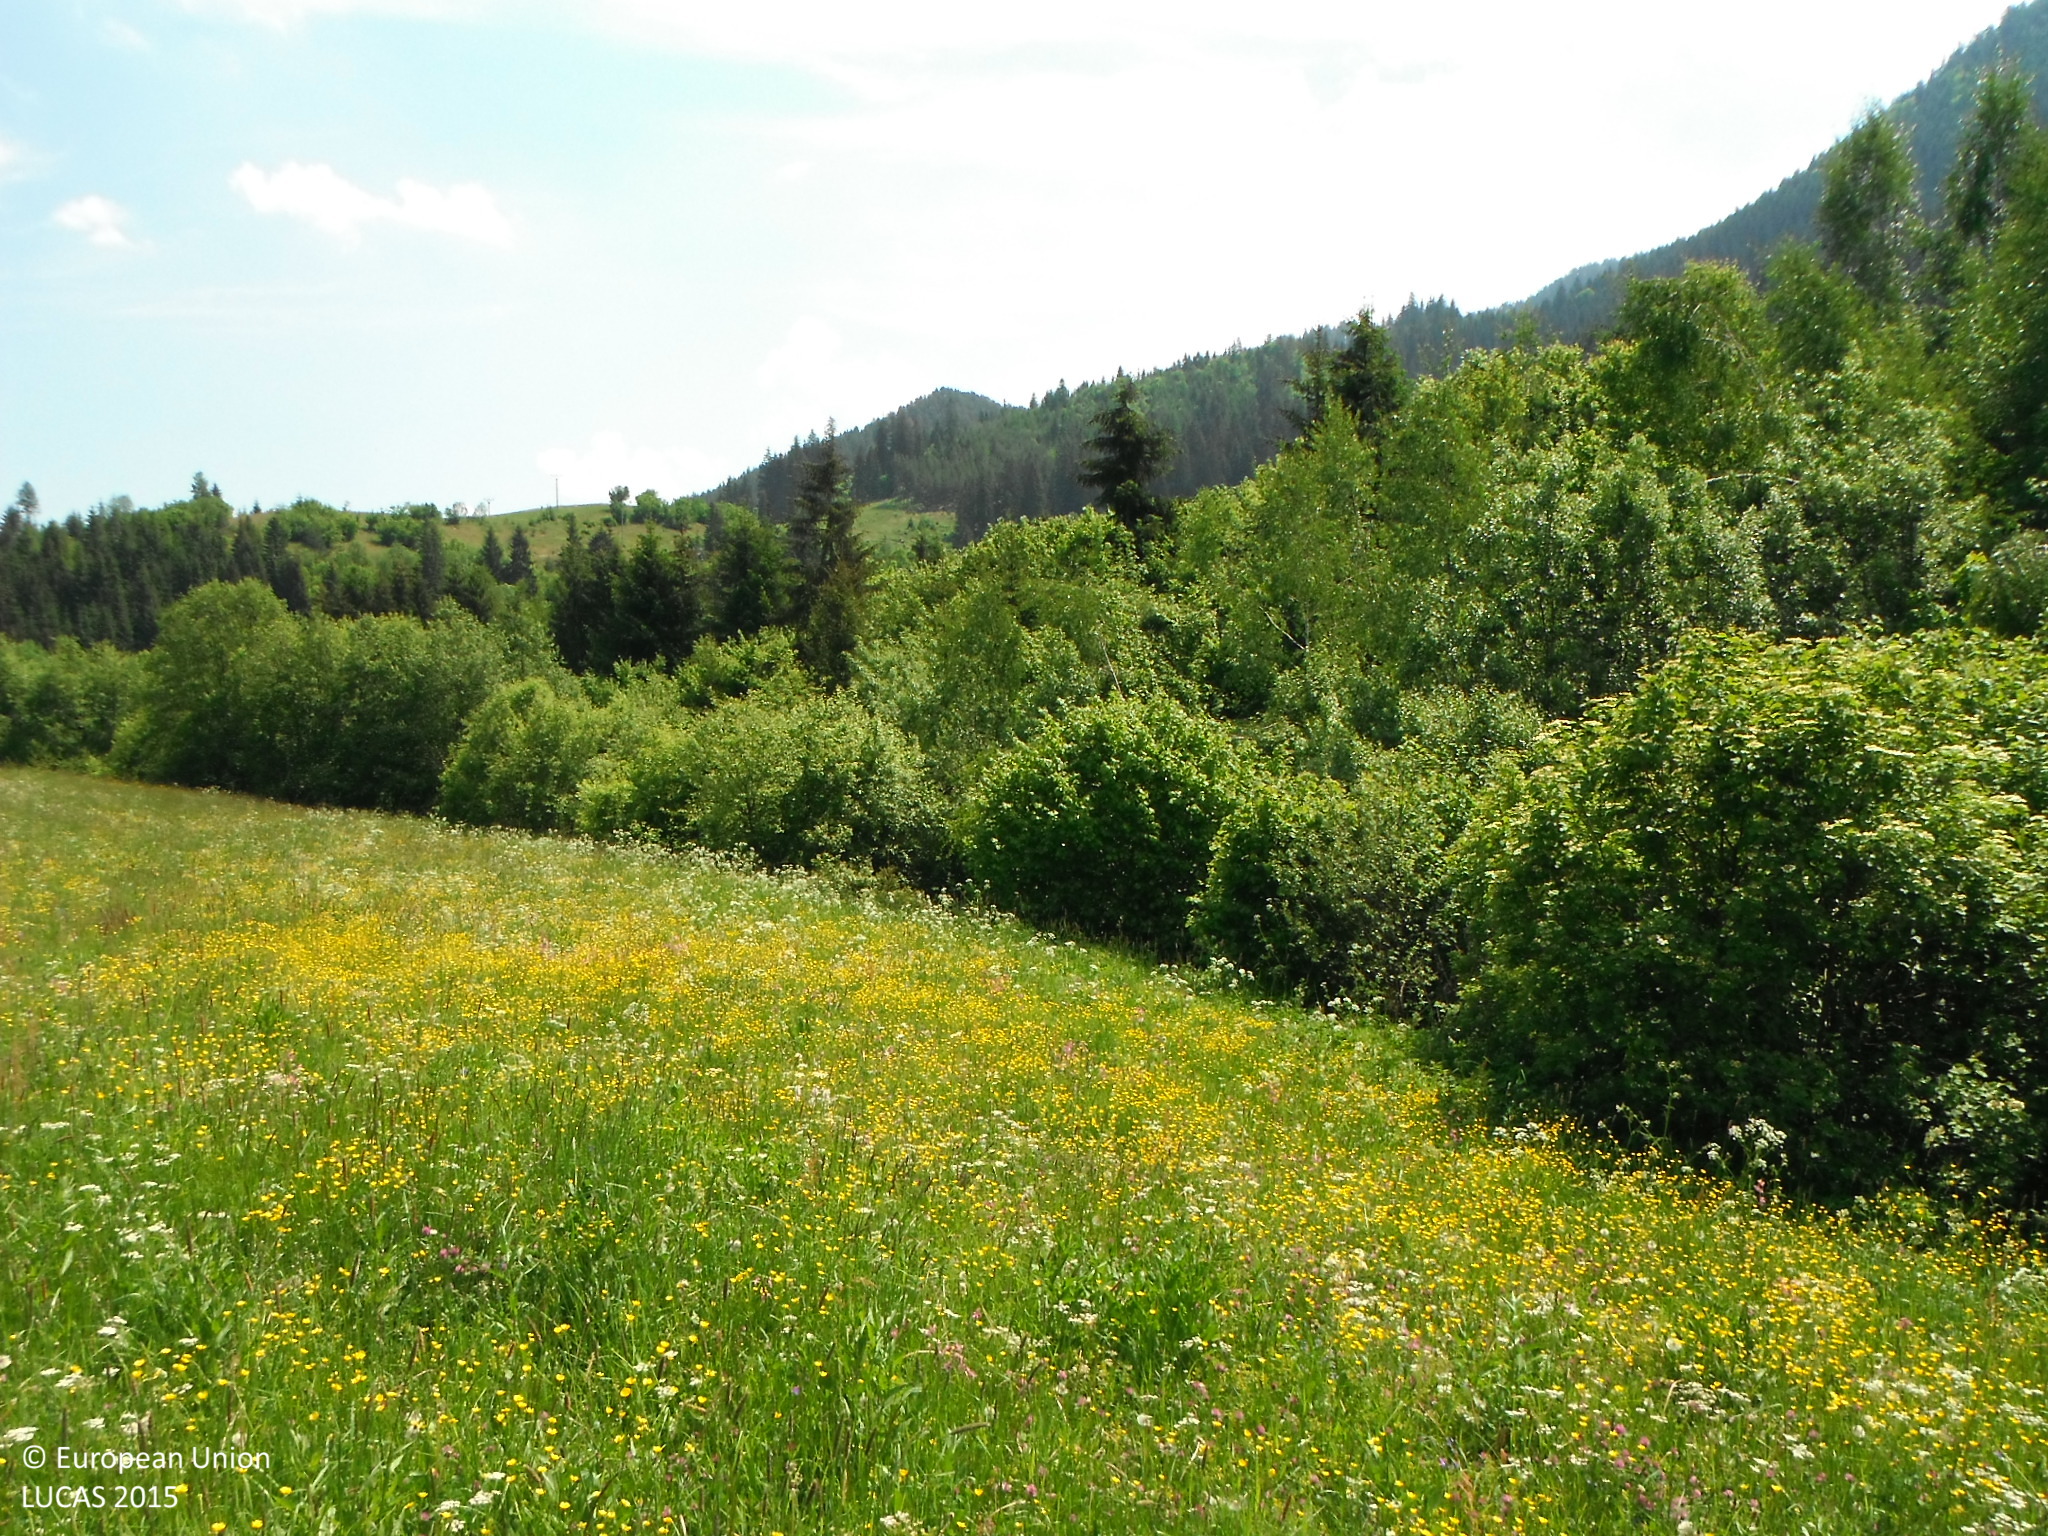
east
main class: Grassland
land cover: Grassland without tree/shrub cover
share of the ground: > 75 %
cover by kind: herbaceous plants 100 %
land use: Agriculture (excluding fallow land and kitchen gardens)
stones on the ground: > 50 %
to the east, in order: Grassland without tree/shrub cover; Shrubland with sparse tree cover; Rivers and streams; Other mixed woodland; Artificial constructions in urban areas; Broadleaved woodland; Grassland without tree/shrub cover; Broadleaved woodland; Grassland without tree/shrub cover
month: June
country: SK
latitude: 49.0249
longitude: 19.7241
